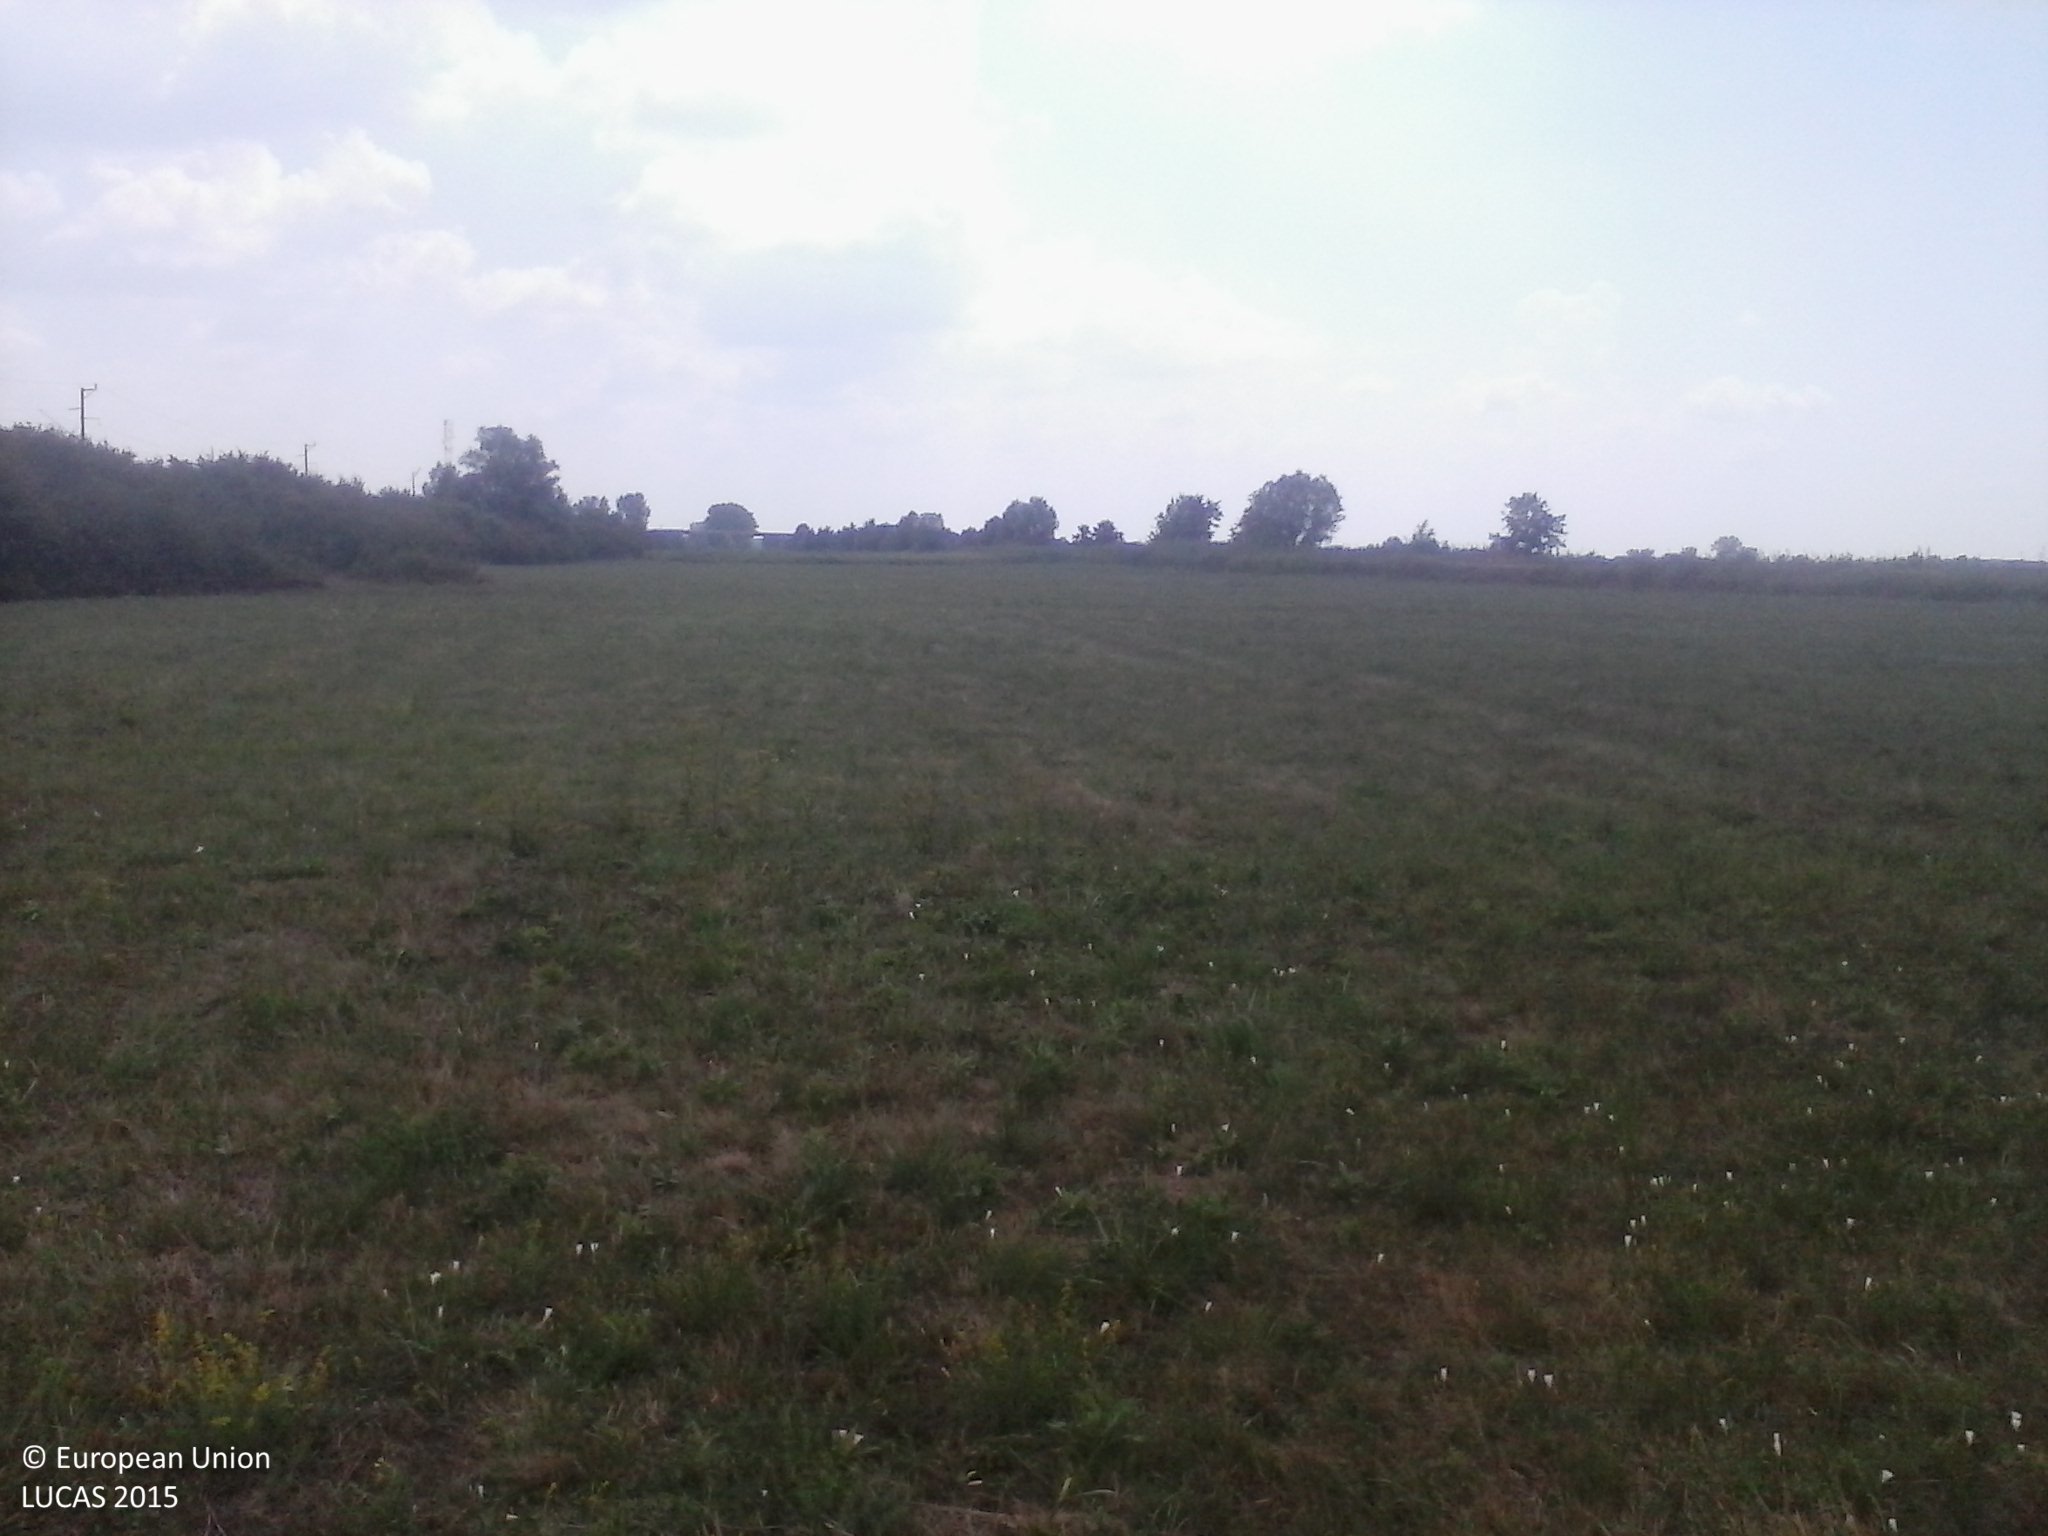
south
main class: Grassland
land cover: Grassland without tree/shrub cover
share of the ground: > 75 %
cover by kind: herbaceous plants 100 %
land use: Agriculture (excluding fallow land and kitchen gardens)
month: August
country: HU
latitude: 46.0527
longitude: 17.9803
